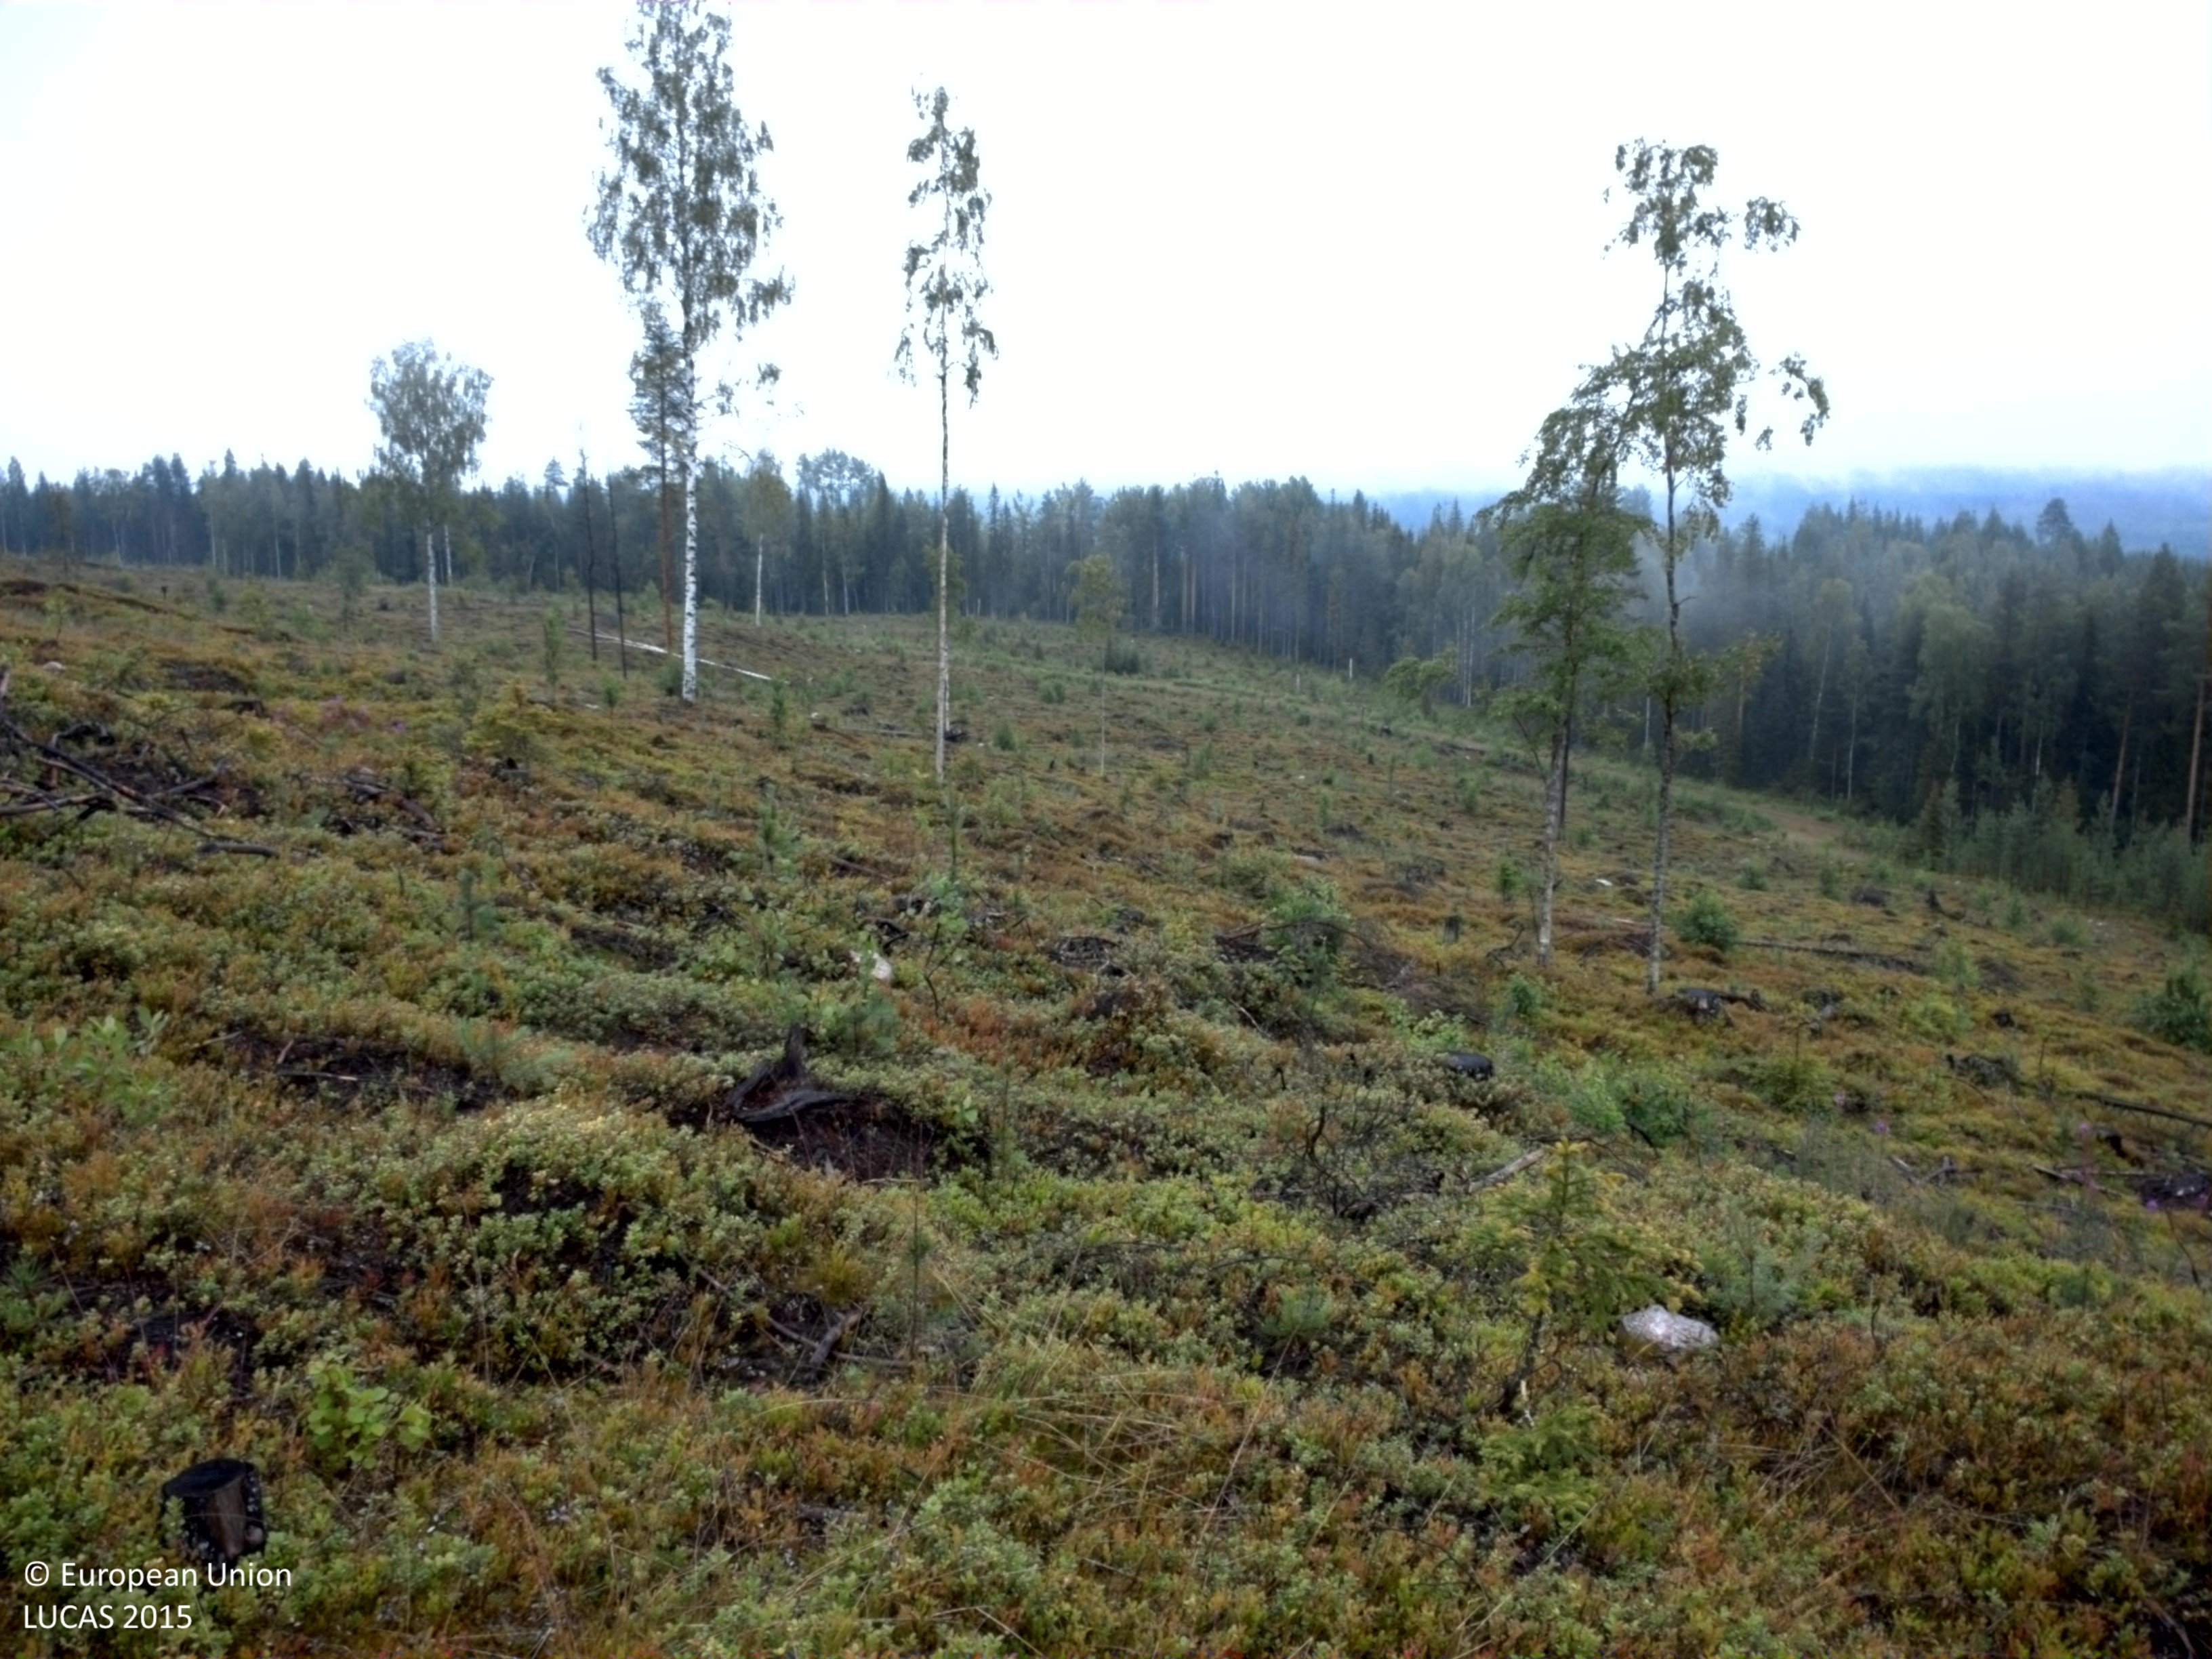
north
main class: Shrubland
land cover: Shrubland with sparse tree cover
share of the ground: > 75 %
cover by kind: shrubs 90 %, coniferous forest trees 5 %, unconsolidated bare surface 5 %
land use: Forestry
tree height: < 5 m
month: August
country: SE
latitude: 66.3494
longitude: 20.5245
